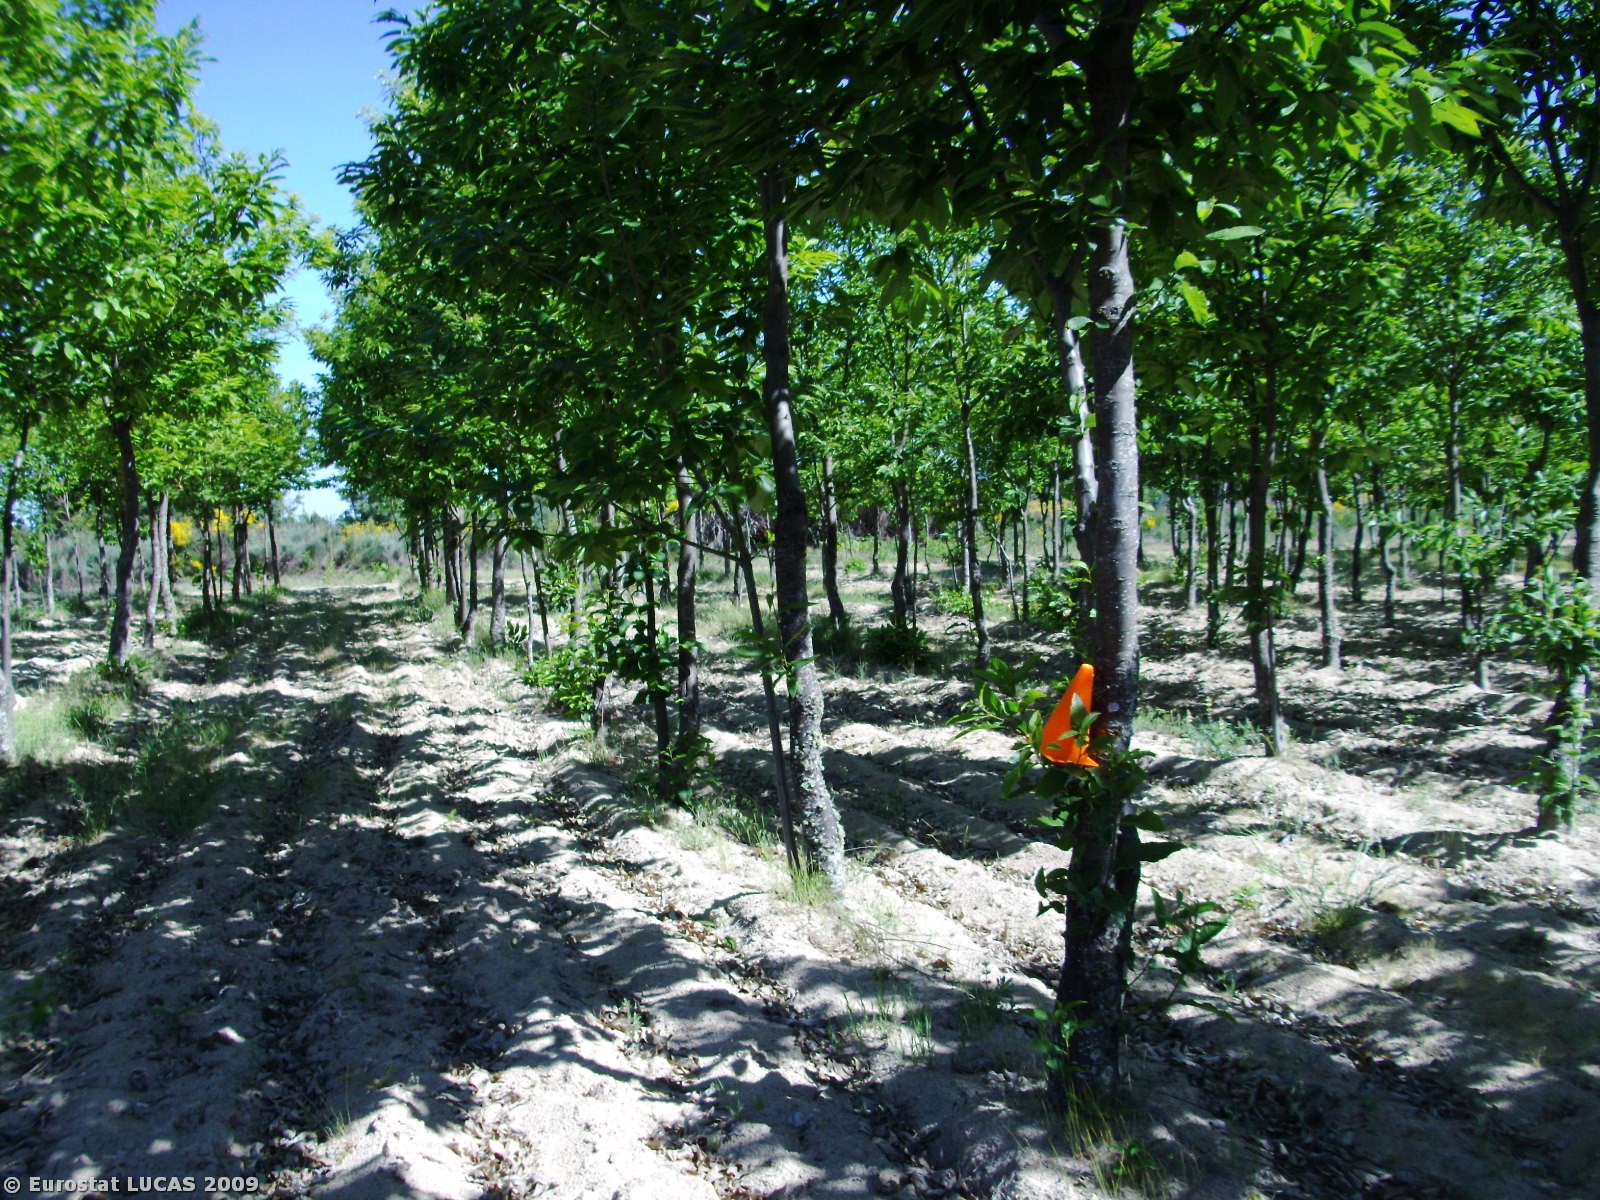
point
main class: Woodland
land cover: Broadleaved woodland
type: mesophytic deciduous forest
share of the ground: 50 - 75 %
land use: Forestry
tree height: > 5 m
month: May
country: PT
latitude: 40.8527
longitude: -7.3244
